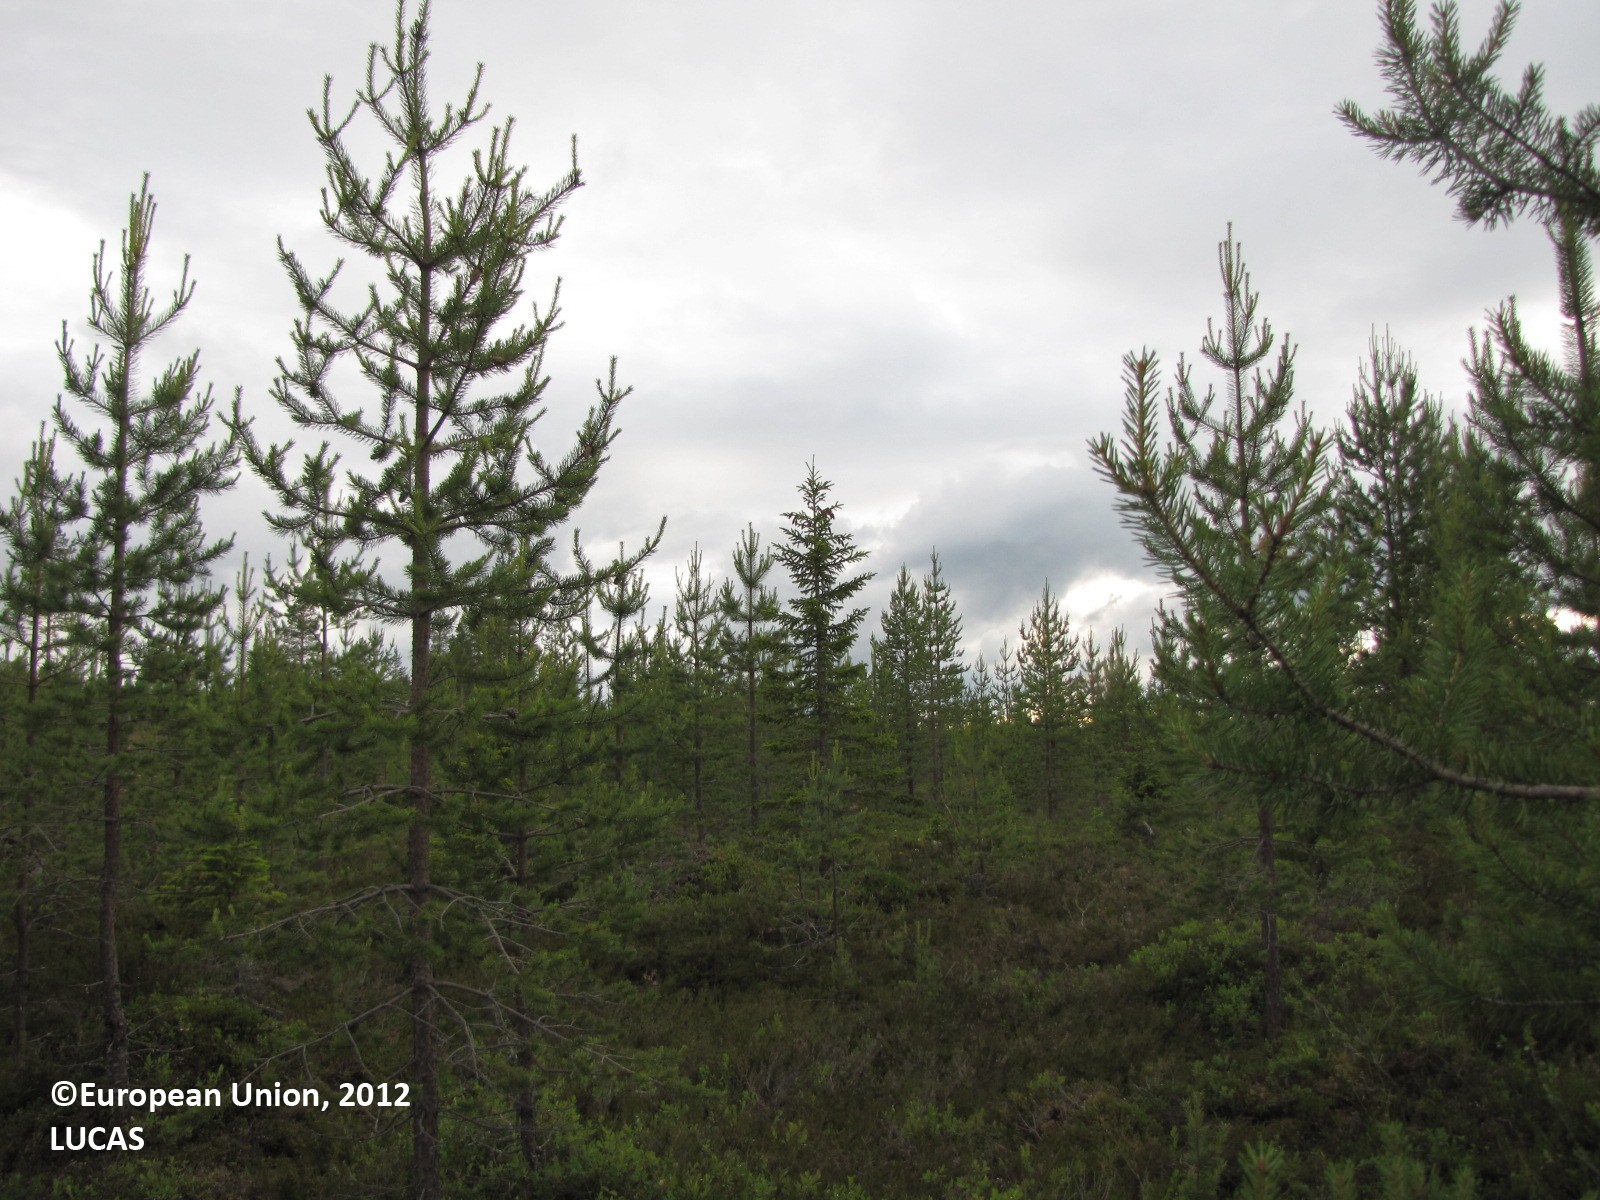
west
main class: Woodland
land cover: Pine dominated coniferous woodland
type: boreal forest
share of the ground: 10 - 25 %
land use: Forestry
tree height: > 5 m
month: July
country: FI
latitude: 66.5481
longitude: 25.1656
